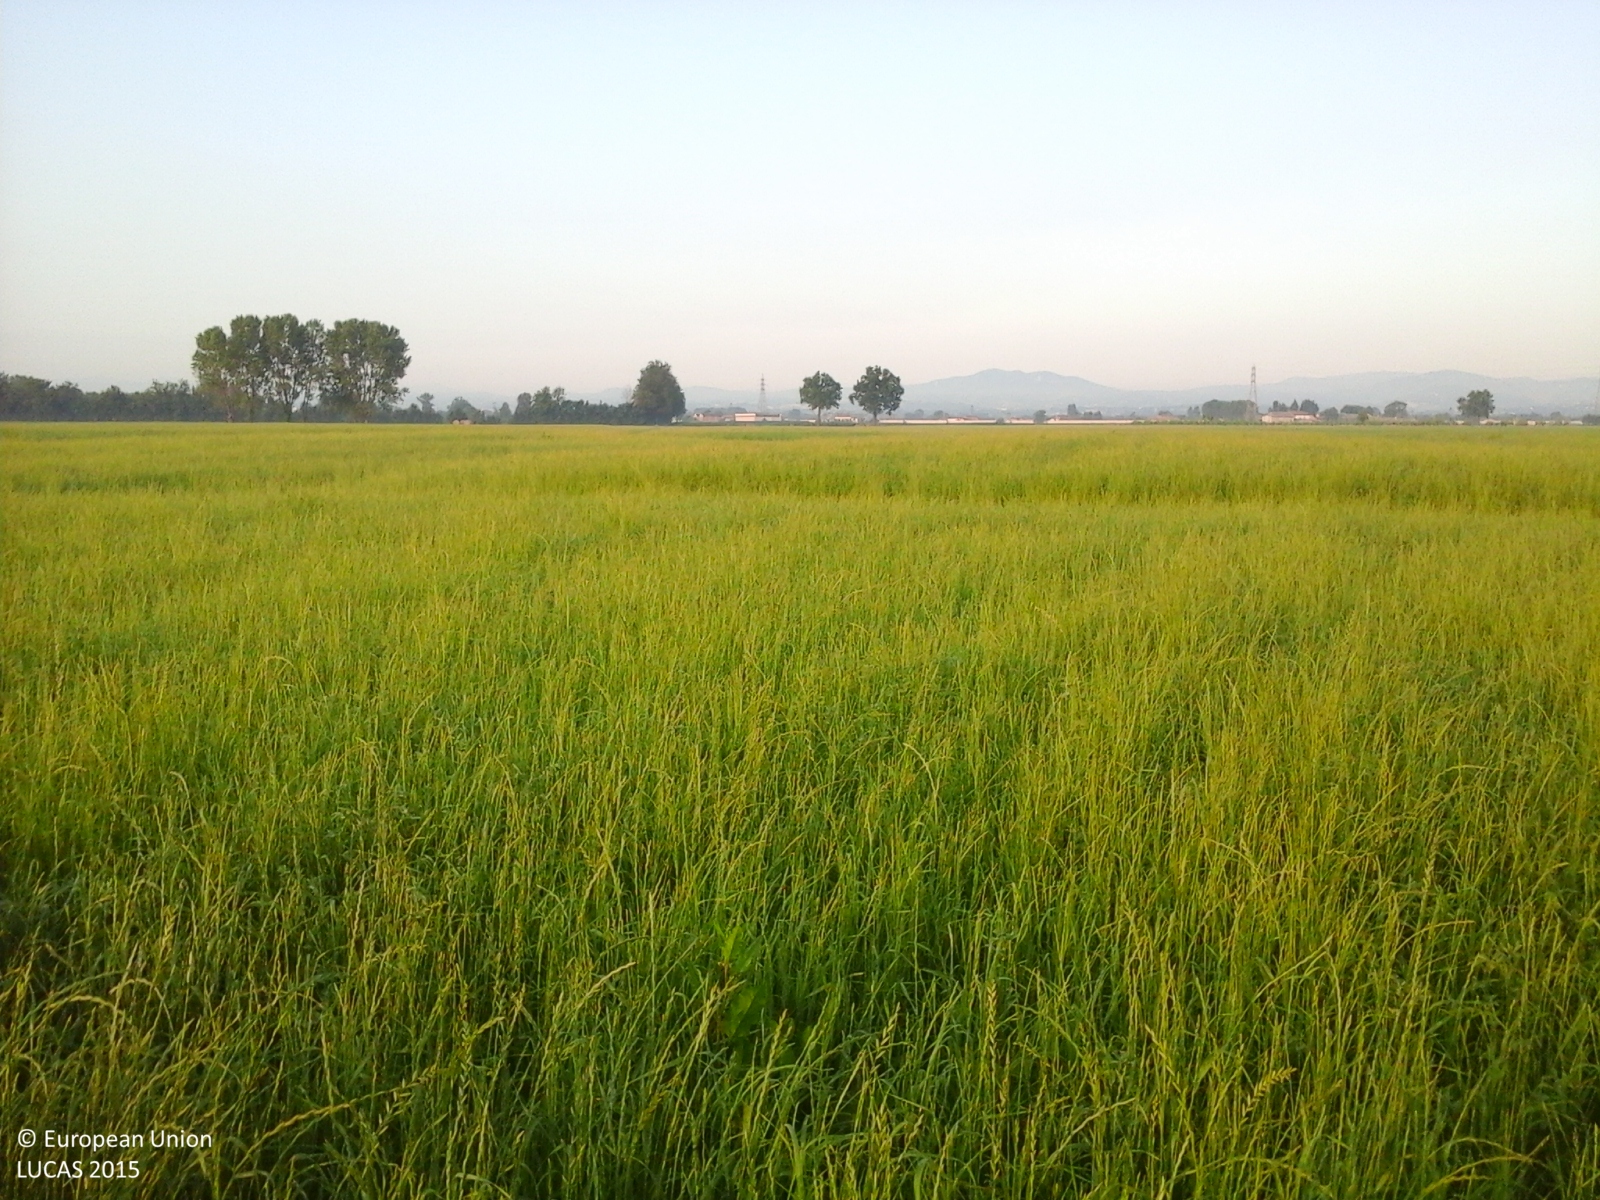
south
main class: Cropland
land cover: Temporary grasslands
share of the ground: > 75 %
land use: Agriculture (excluding fallow land and kitchen gardens)
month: June
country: IT
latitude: 44.9276
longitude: 10.0126
